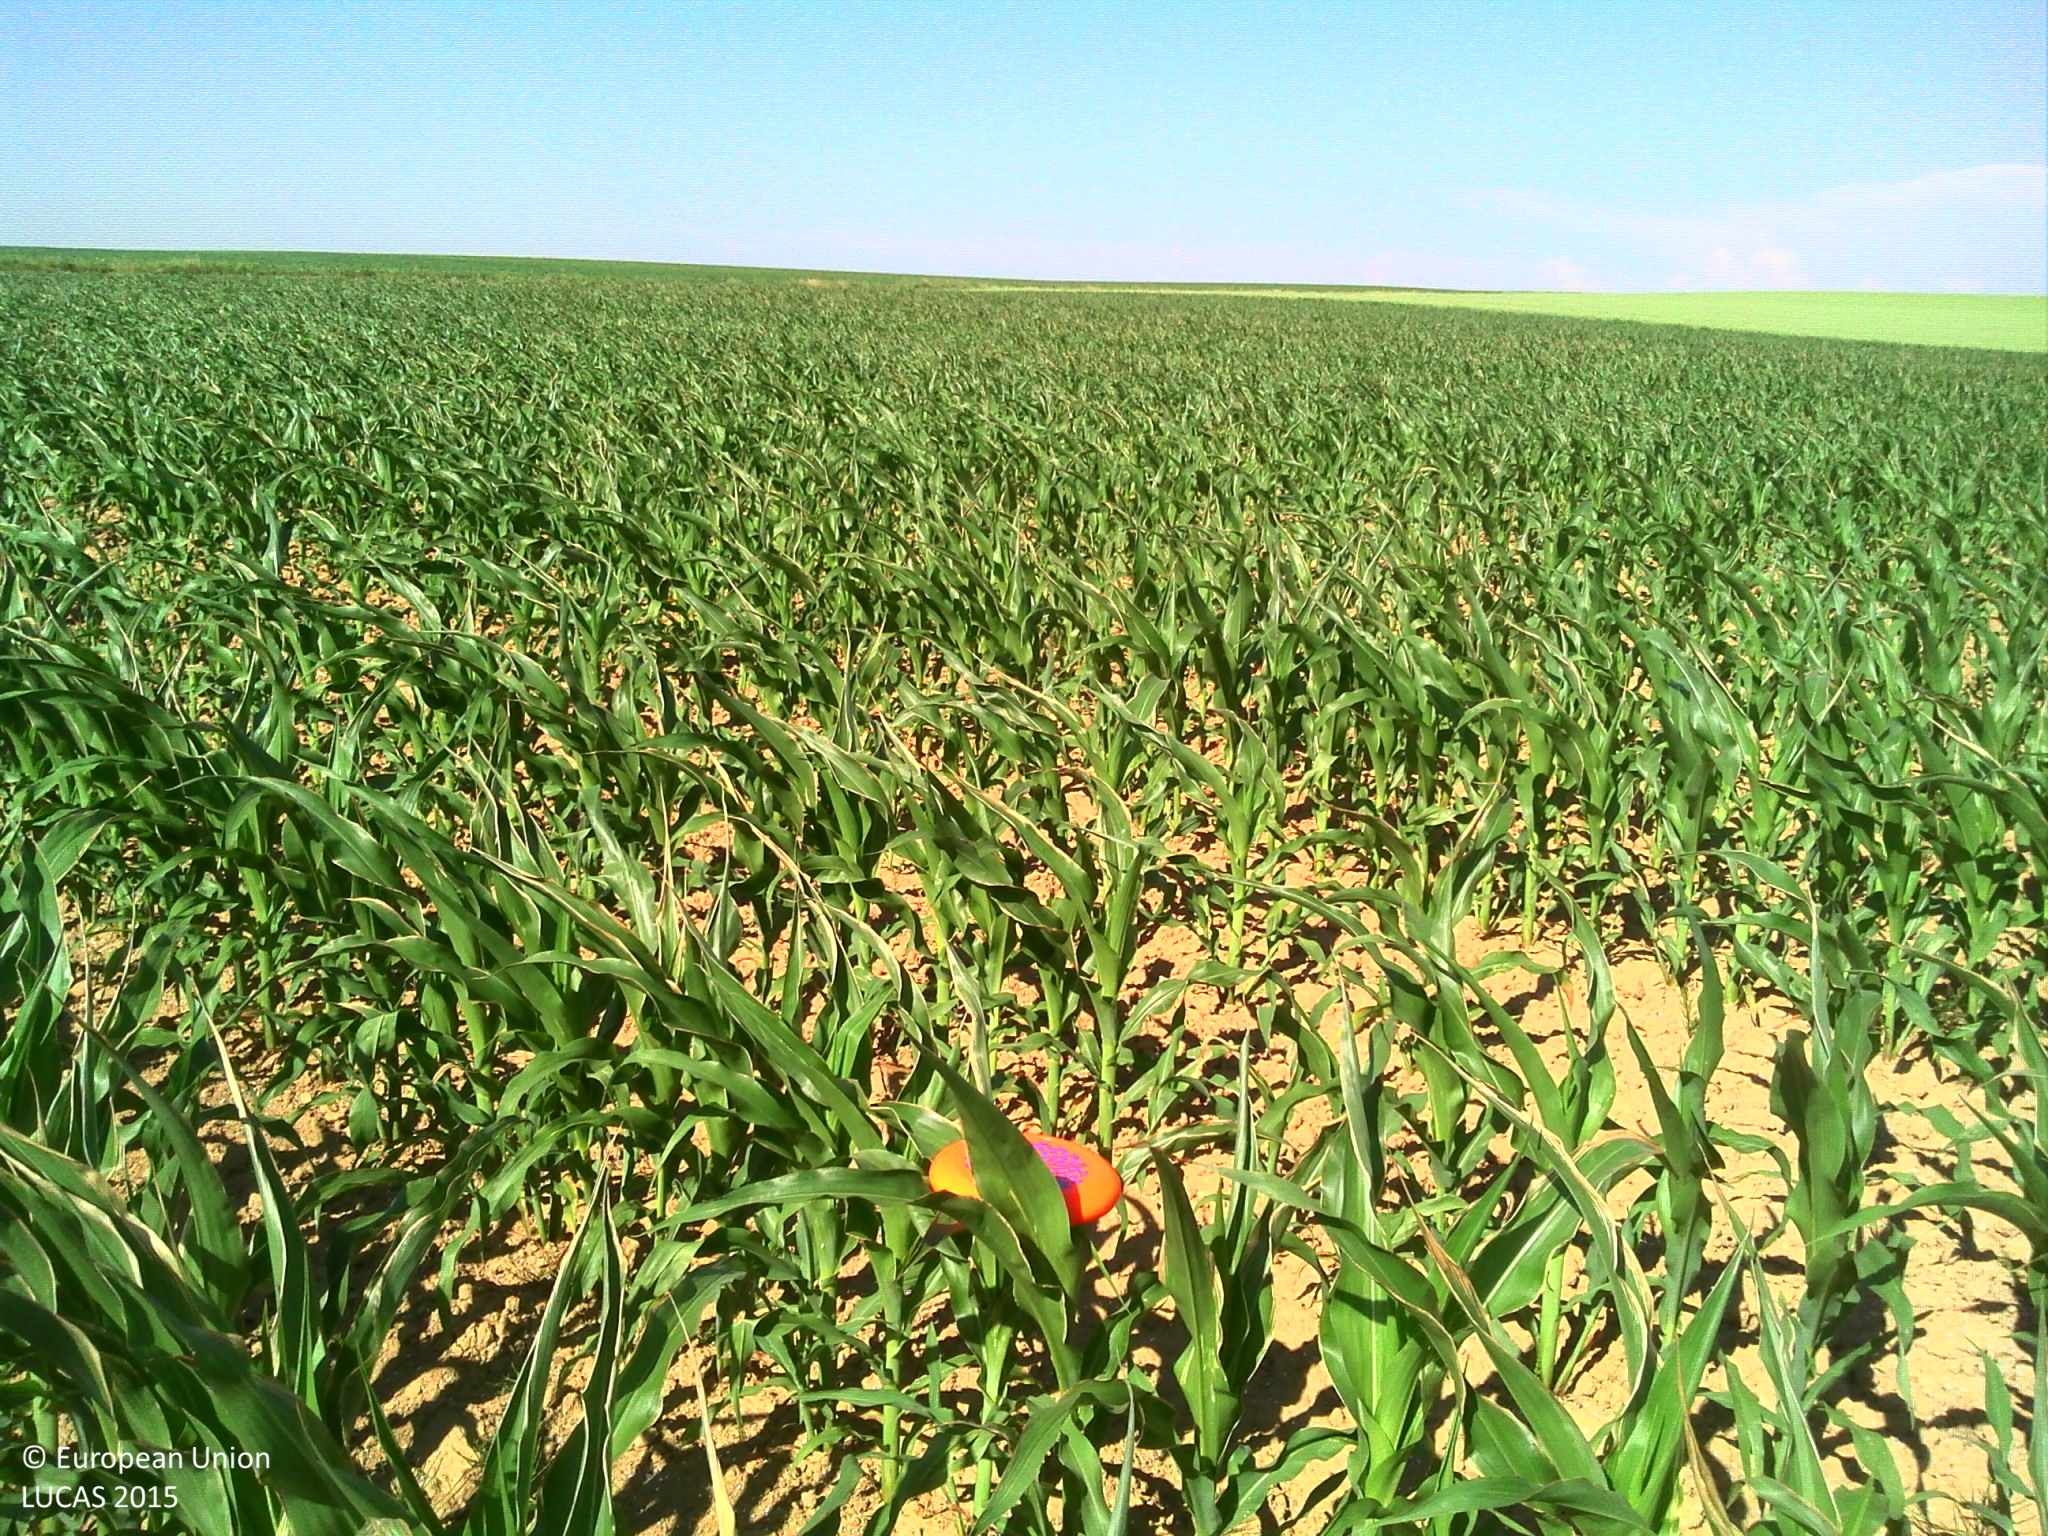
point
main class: Cropland
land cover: Maize
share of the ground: 50 - 75 %
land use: Agriculture (excluding fallow land and kitchen gardens)
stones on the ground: 10 - 25 %
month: June
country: FR
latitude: 45.9734
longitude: 4.8276
